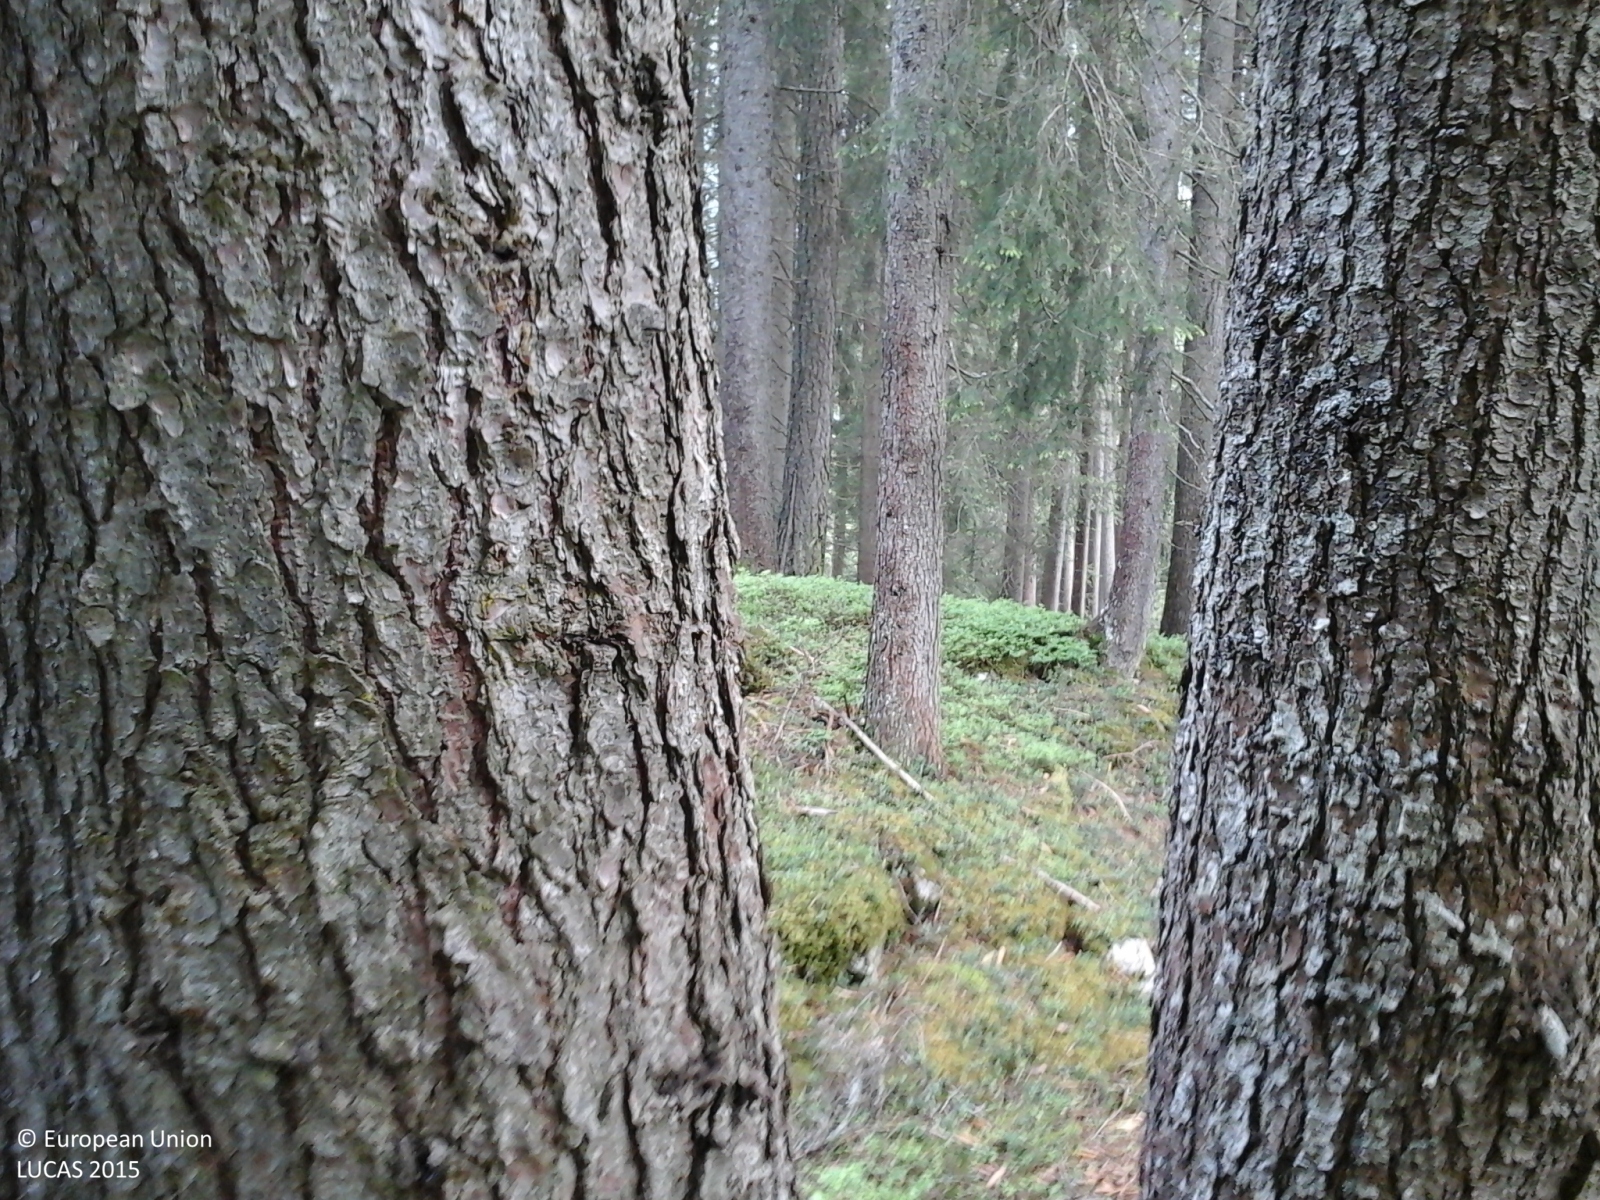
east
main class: Woodland
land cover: Spruce dominated coniferous woodland
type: alpine coniferous forest
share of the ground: > 75 %
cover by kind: coniferous forest trees 100 %
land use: Forestry
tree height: > 5 m
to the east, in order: Spruce dominated coniferous woodland; Tracks; Spruce dominated mixed woodland; Grassland without tree/shrub cover
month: June
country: IT
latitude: 46.9699
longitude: 11.5888
